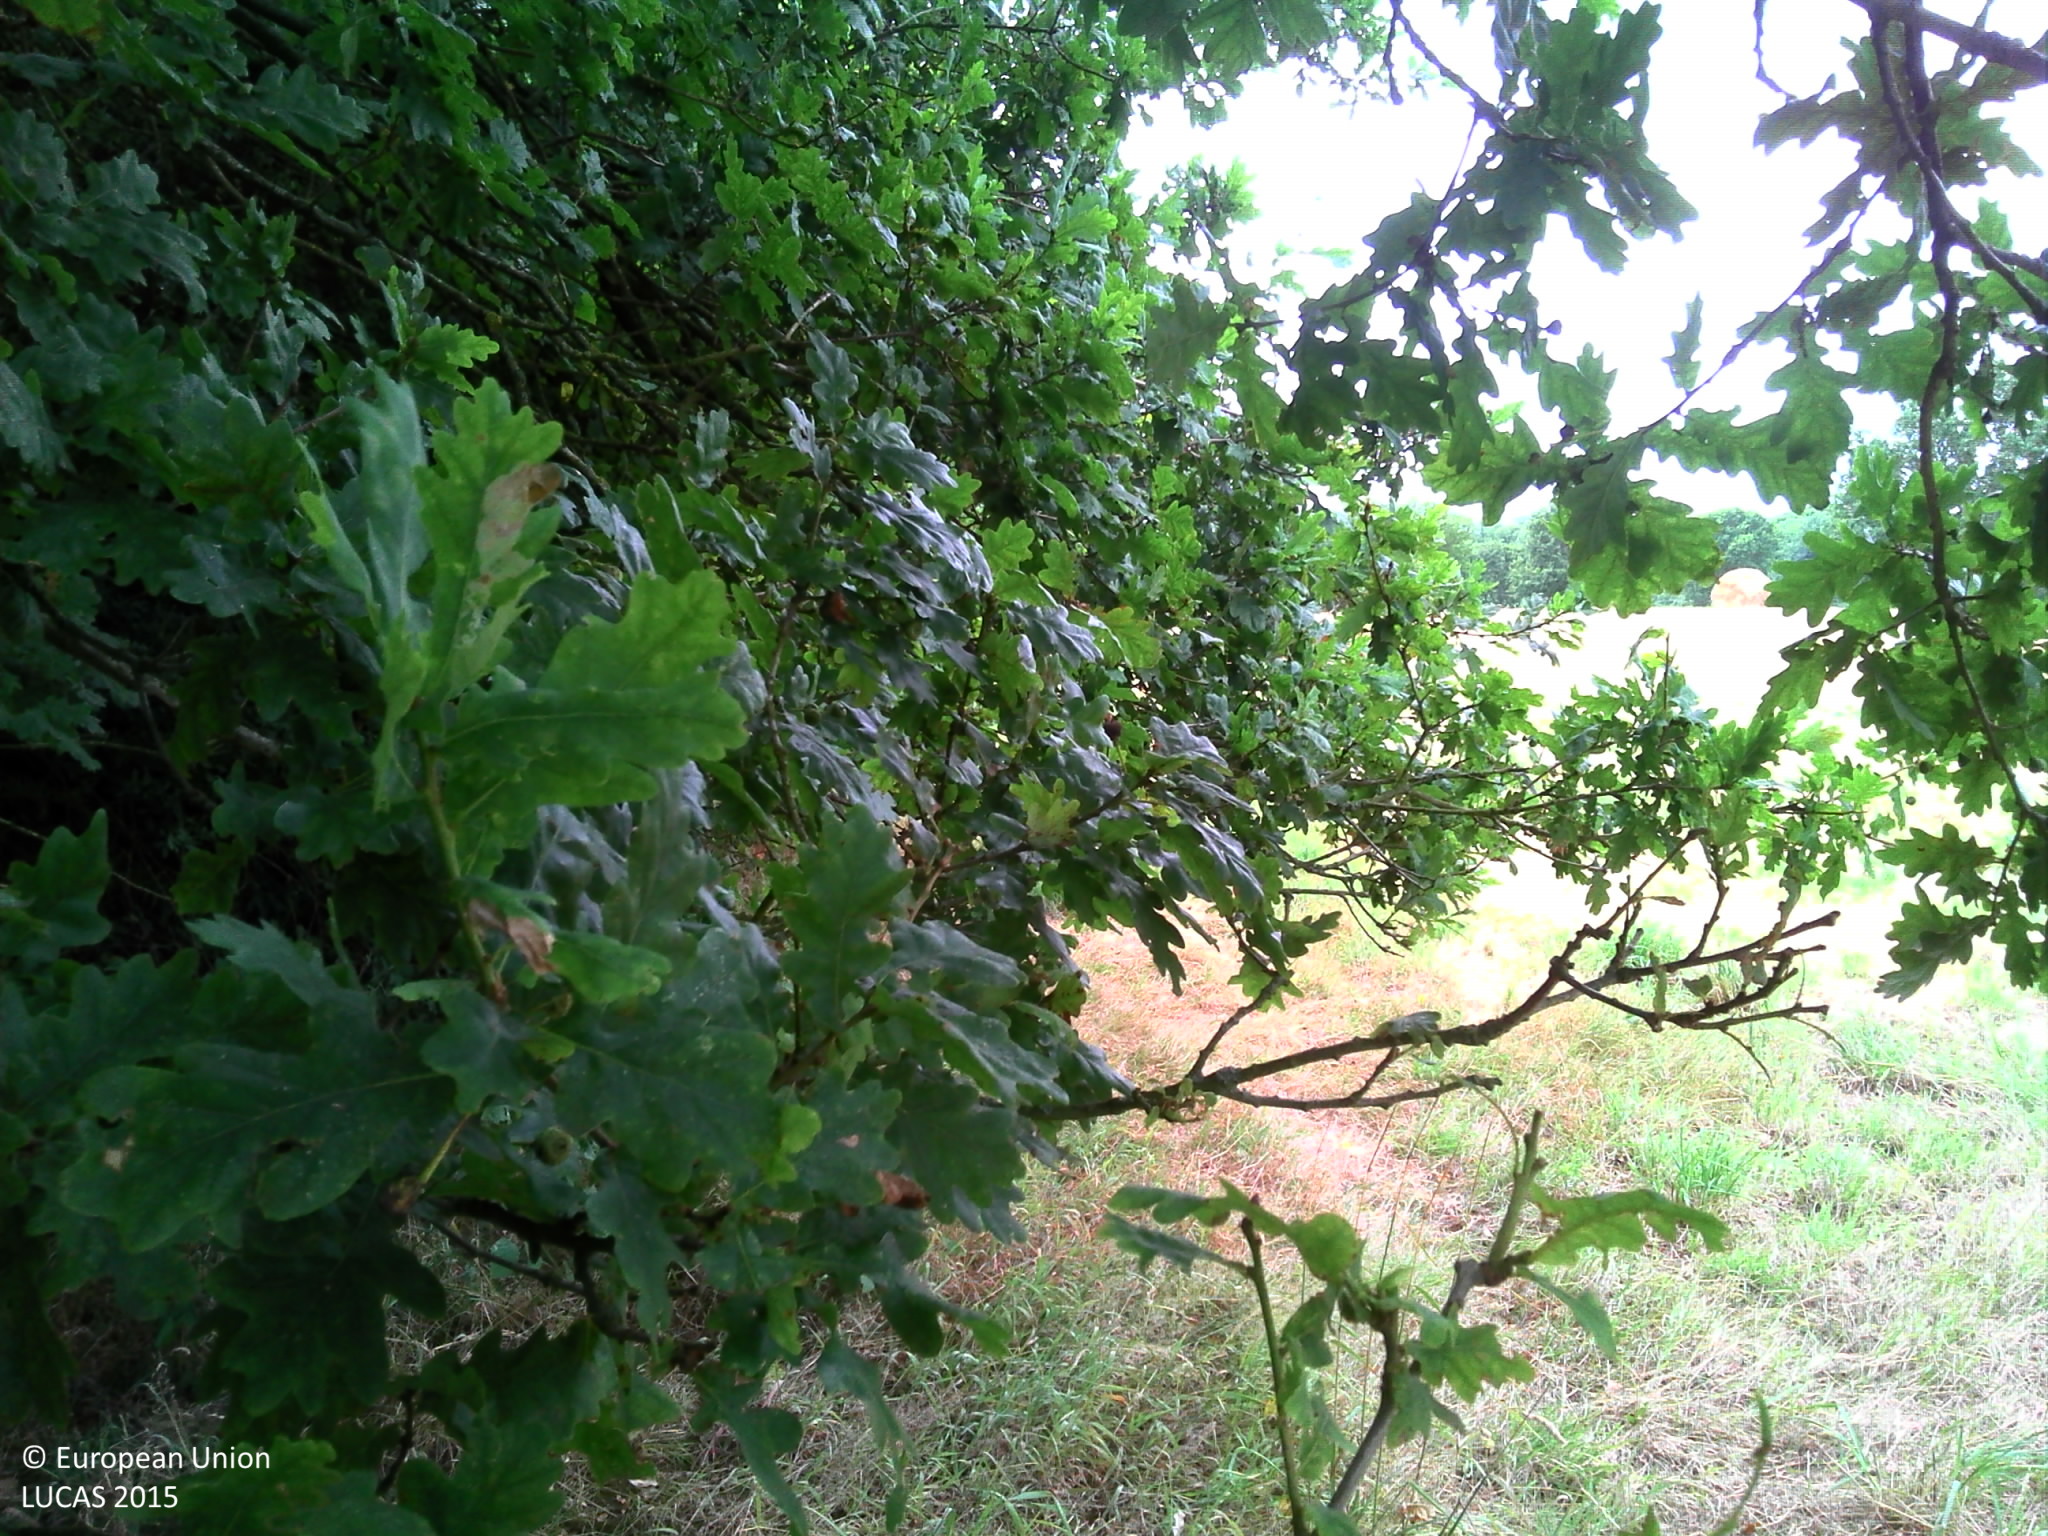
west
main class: Woodland
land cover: Broadleaved woodland
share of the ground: > 75 %
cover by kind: broadleaved forest trees 80 %, herbaceous plants 20 %
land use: Semi-natural and natural areas not in use
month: July
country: FR
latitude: 48.3963
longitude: -0.0650
